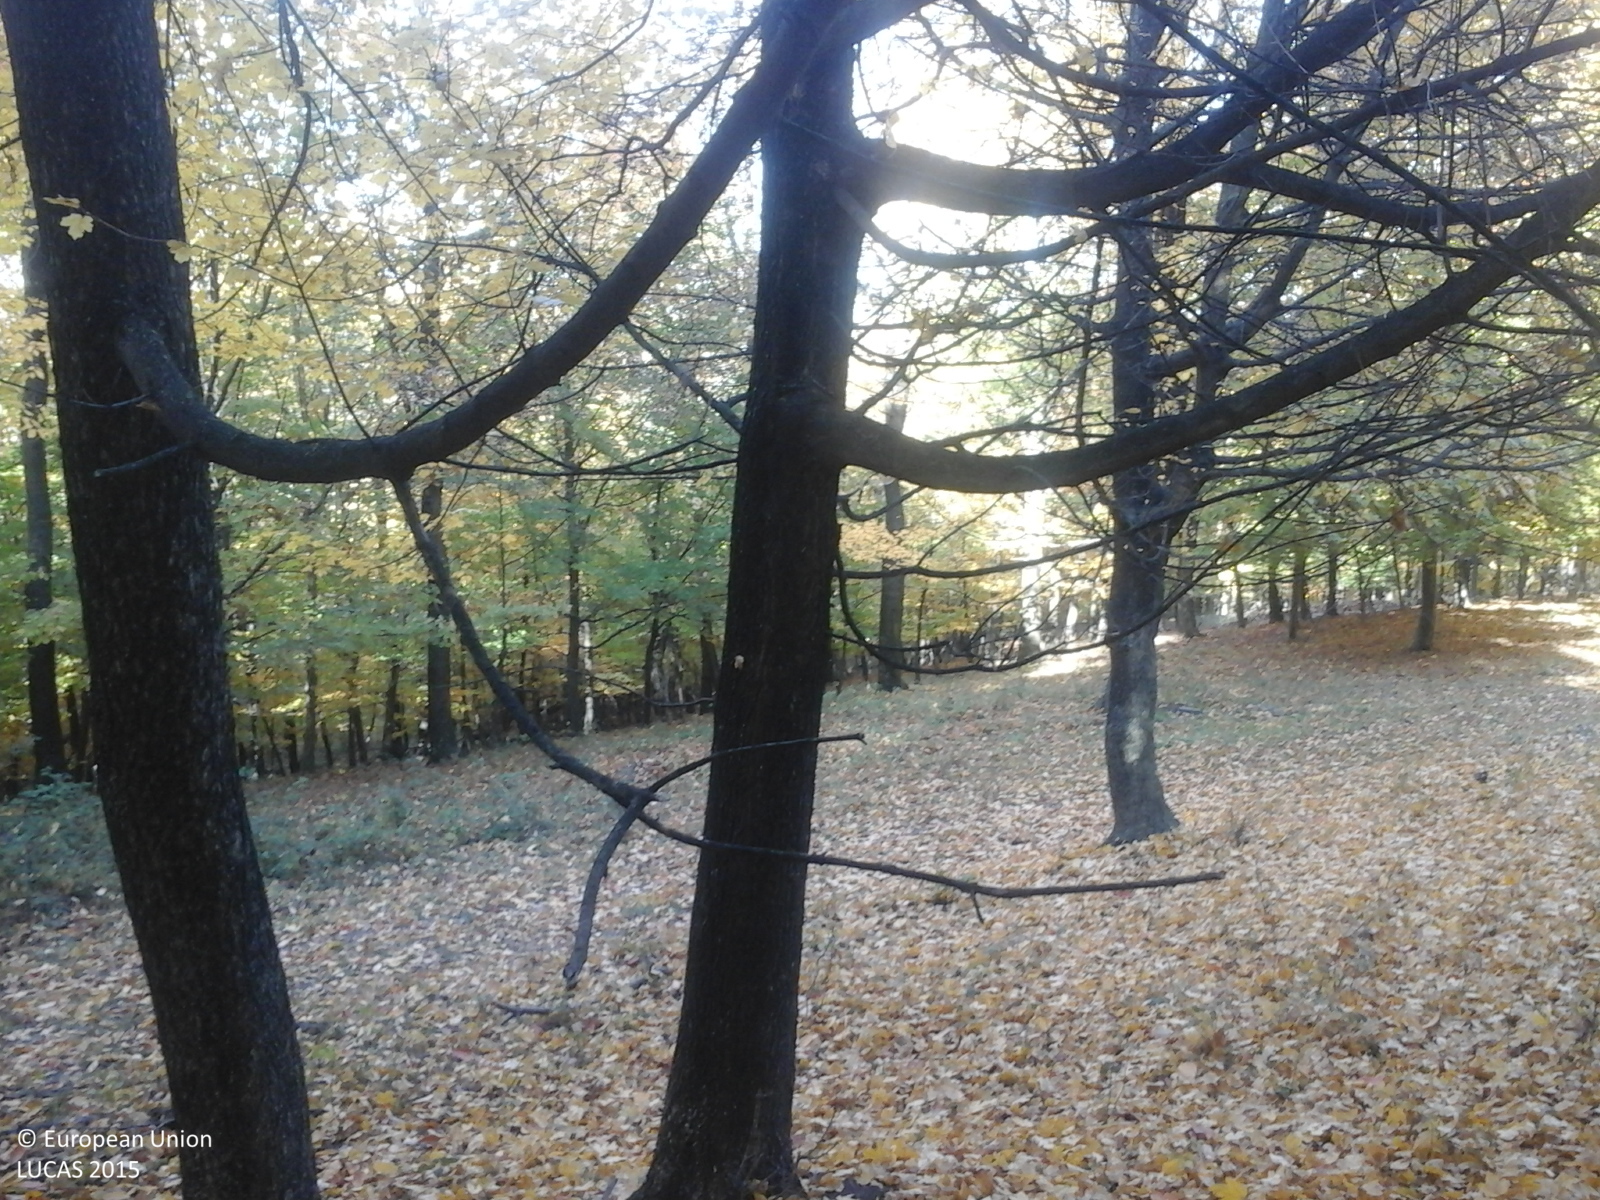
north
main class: Woodland
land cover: Broadleaved woodland
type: beech forest
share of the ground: > 75 %
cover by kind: broadleaved forest trees 100 %
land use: Forestry
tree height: > 5 m
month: October
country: RO
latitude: 46.0696
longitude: 27.0699
